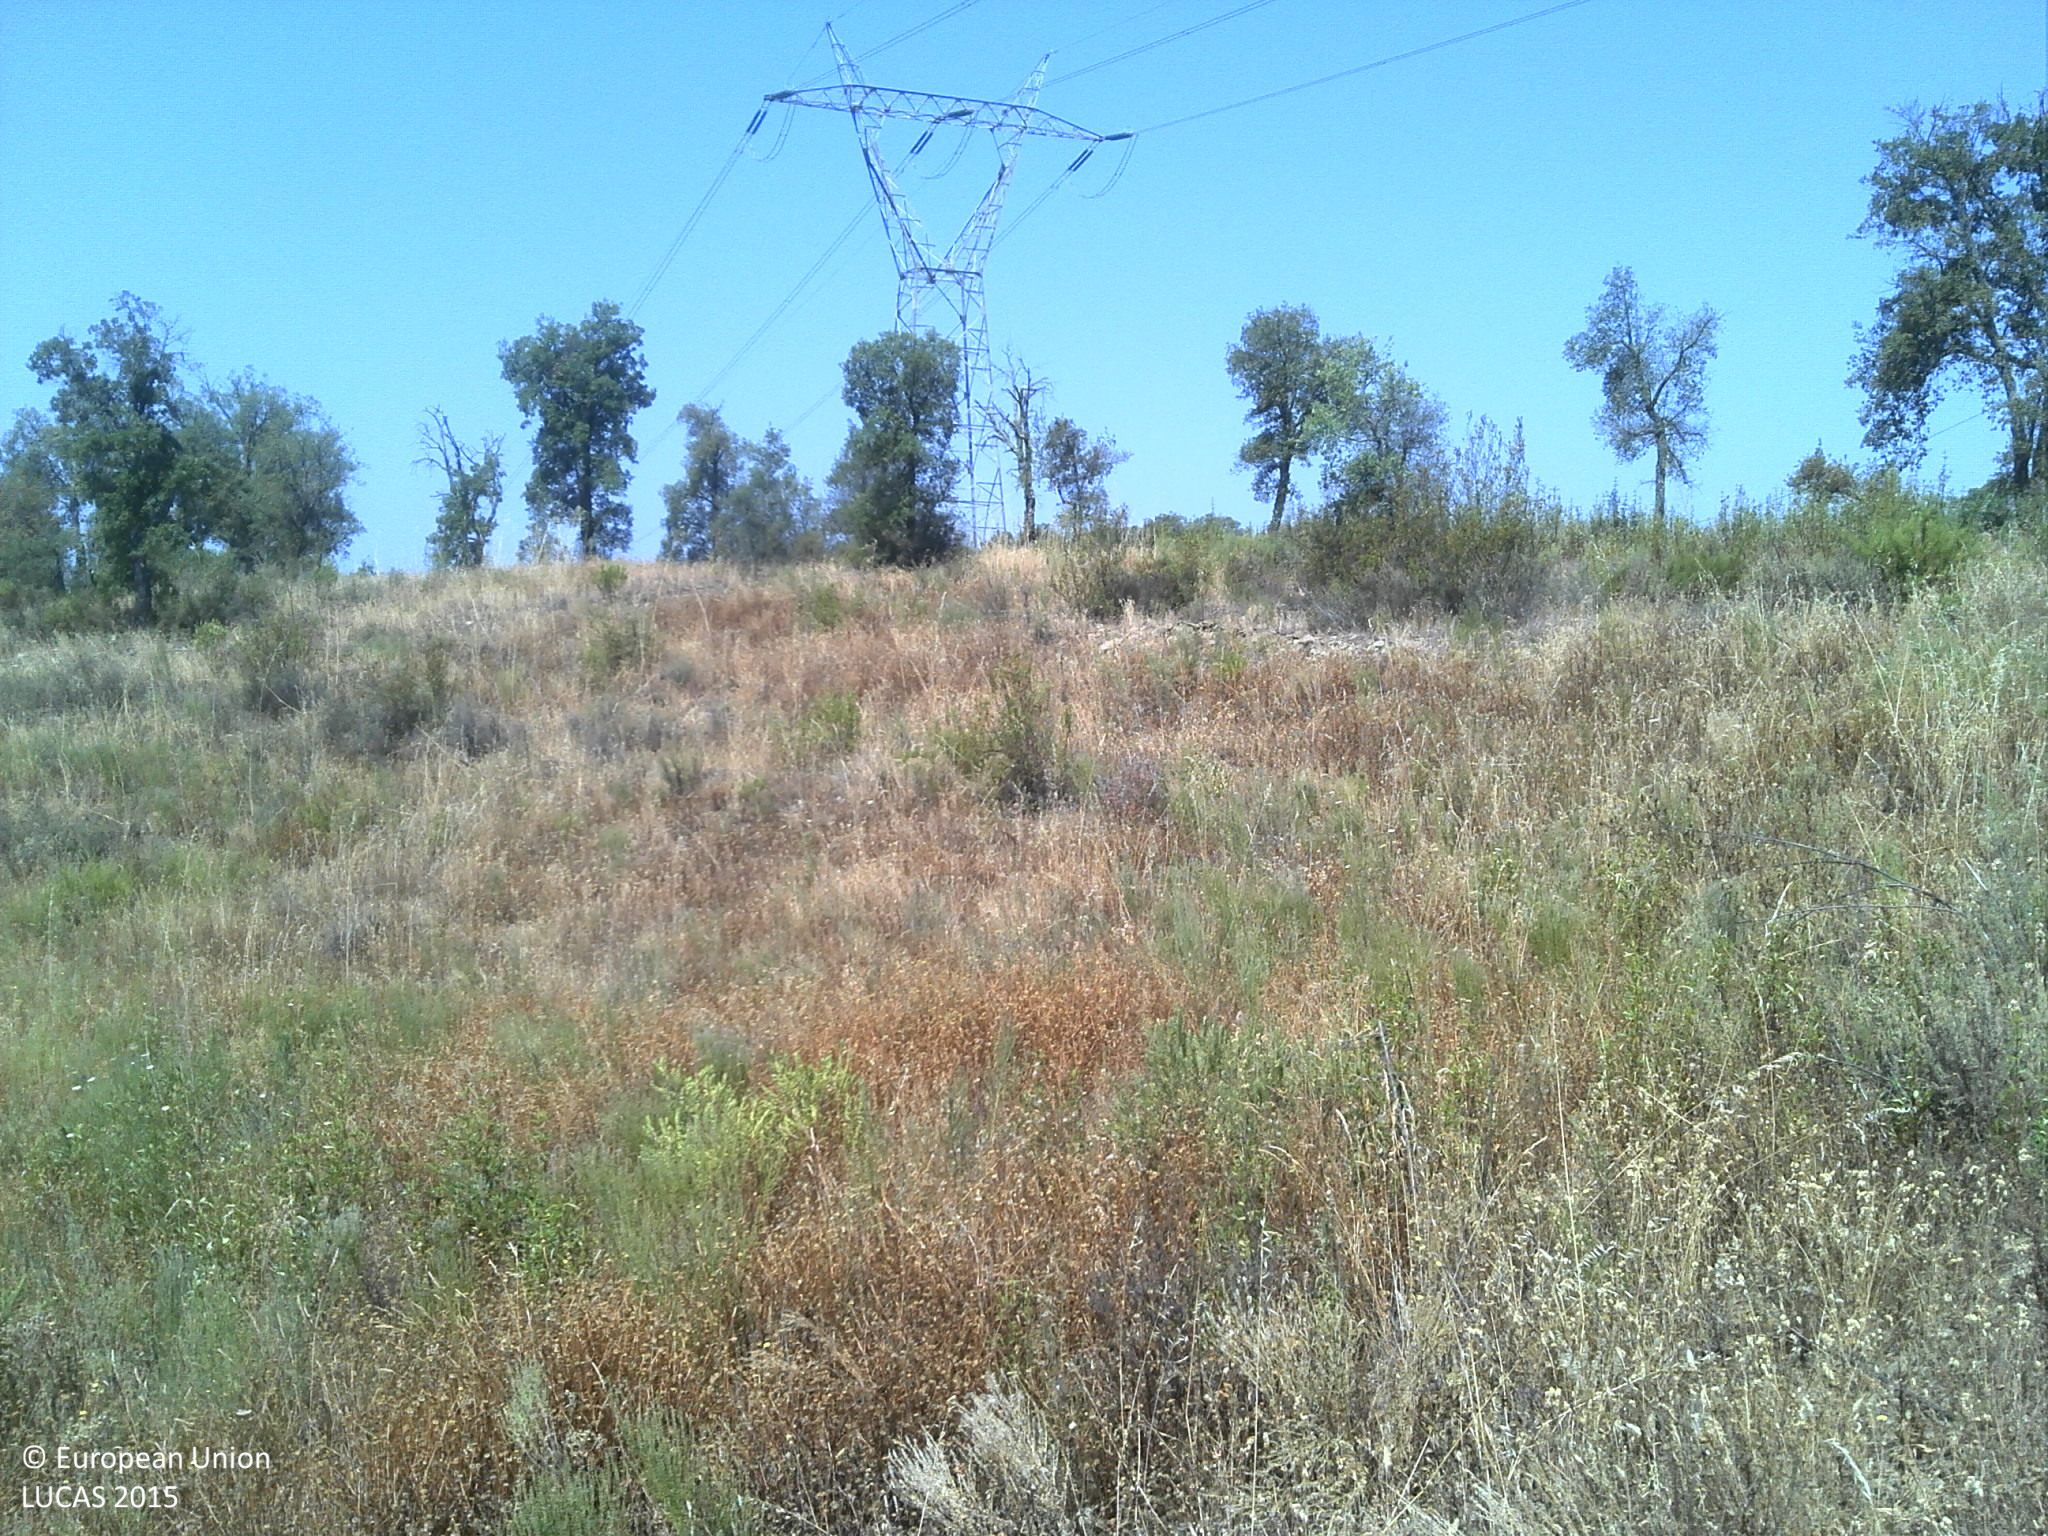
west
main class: Shrubland
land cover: Shrubland with sparse tree cover
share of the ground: > 75 %
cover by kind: shrubs 80 %, lichens and mosses 10 %, broadleaved forest trees 5 %, unconsolidated bare surface 5 %
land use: Semi-natural and natural areas not in use
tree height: < 5 m
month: June
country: PT
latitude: 39.4526
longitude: -7.9178
